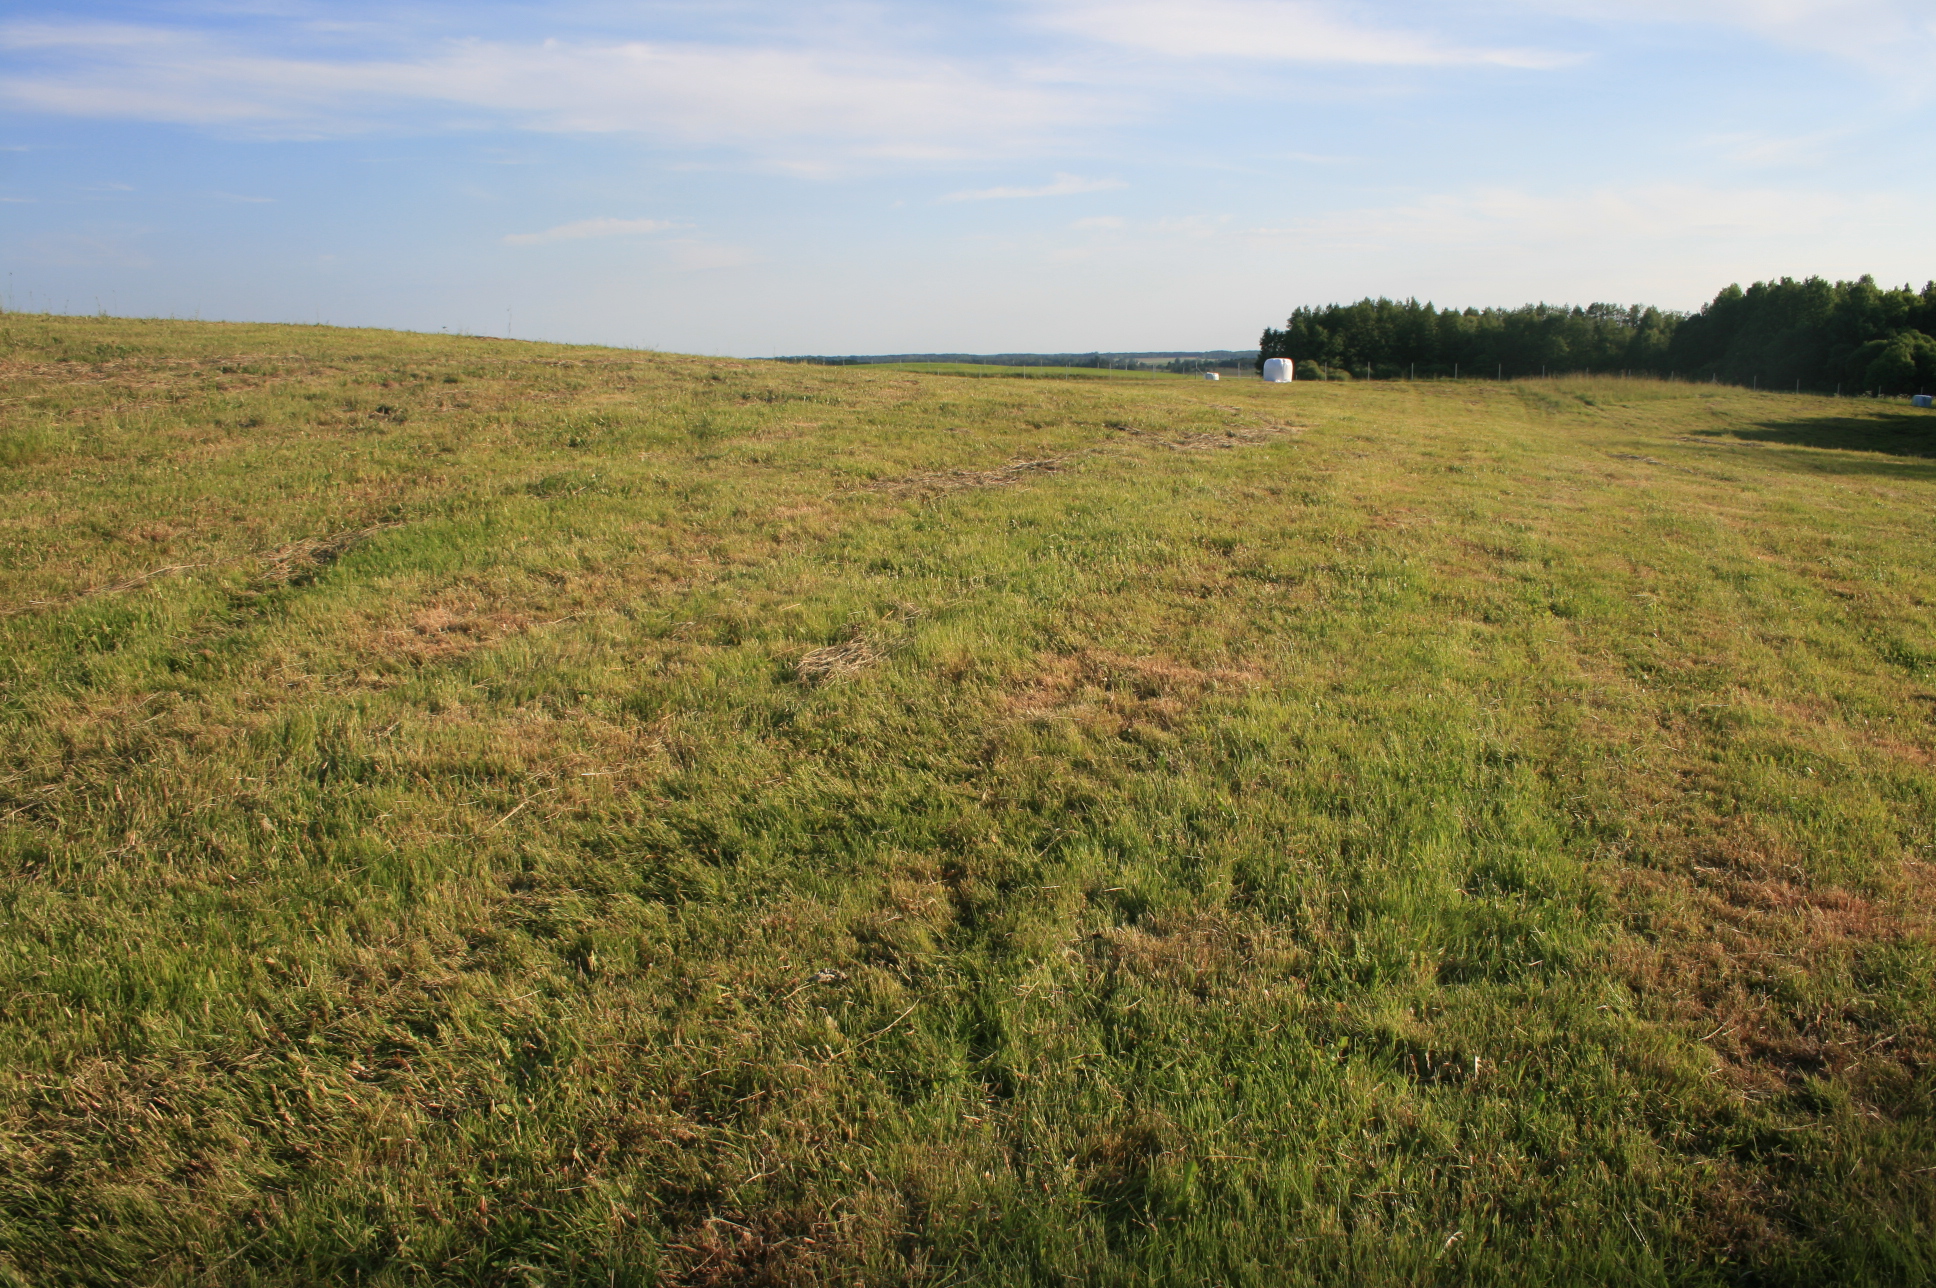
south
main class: Grassland
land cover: Grassland without tree/shrub cover
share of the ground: > 75 %
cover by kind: herbaceous plants 100 %
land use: Agriculture (excluding fallow land and kitchen gardens)
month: June
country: LT
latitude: 55.5678
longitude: 22.1871
